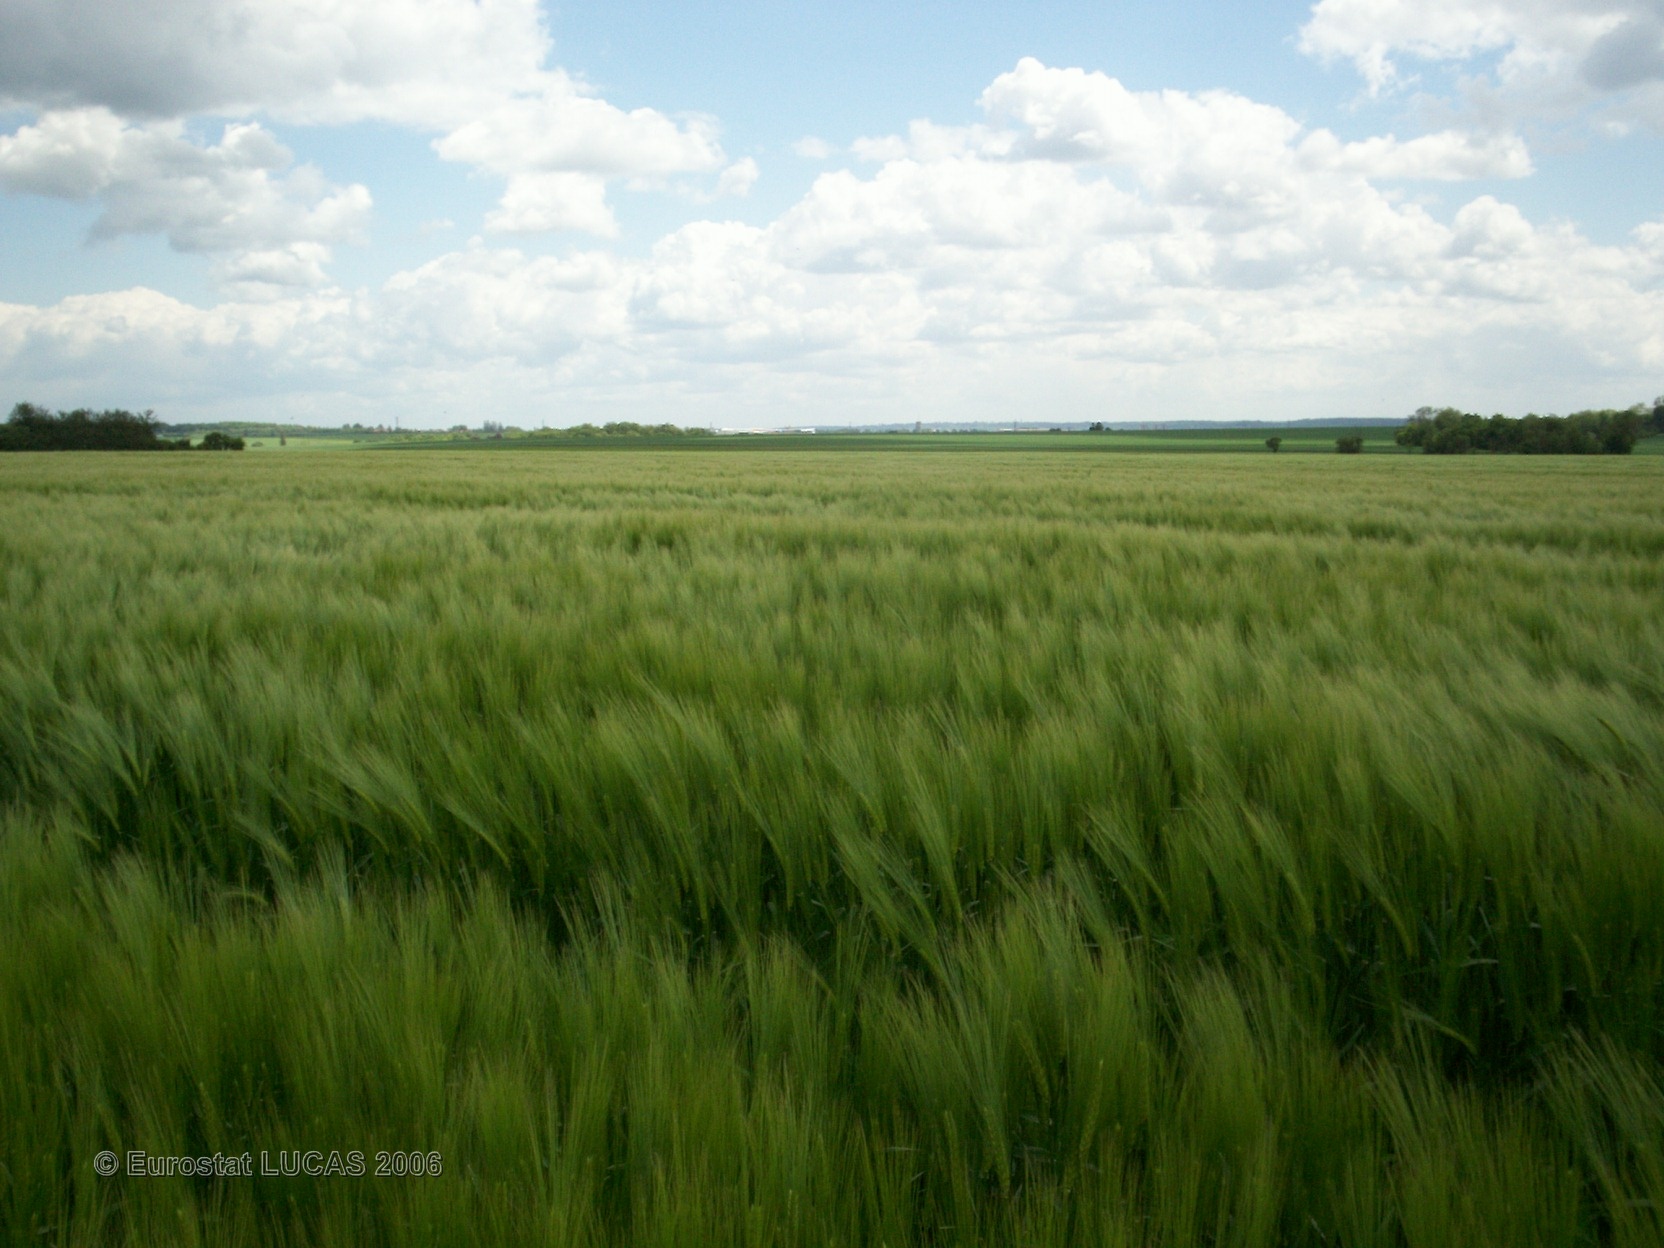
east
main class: Cropland
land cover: Common wheat
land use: Agriculture (excluding fallow land and kitchen gardens)
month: May
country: FR
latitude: 48.9646
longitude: 2.8192
